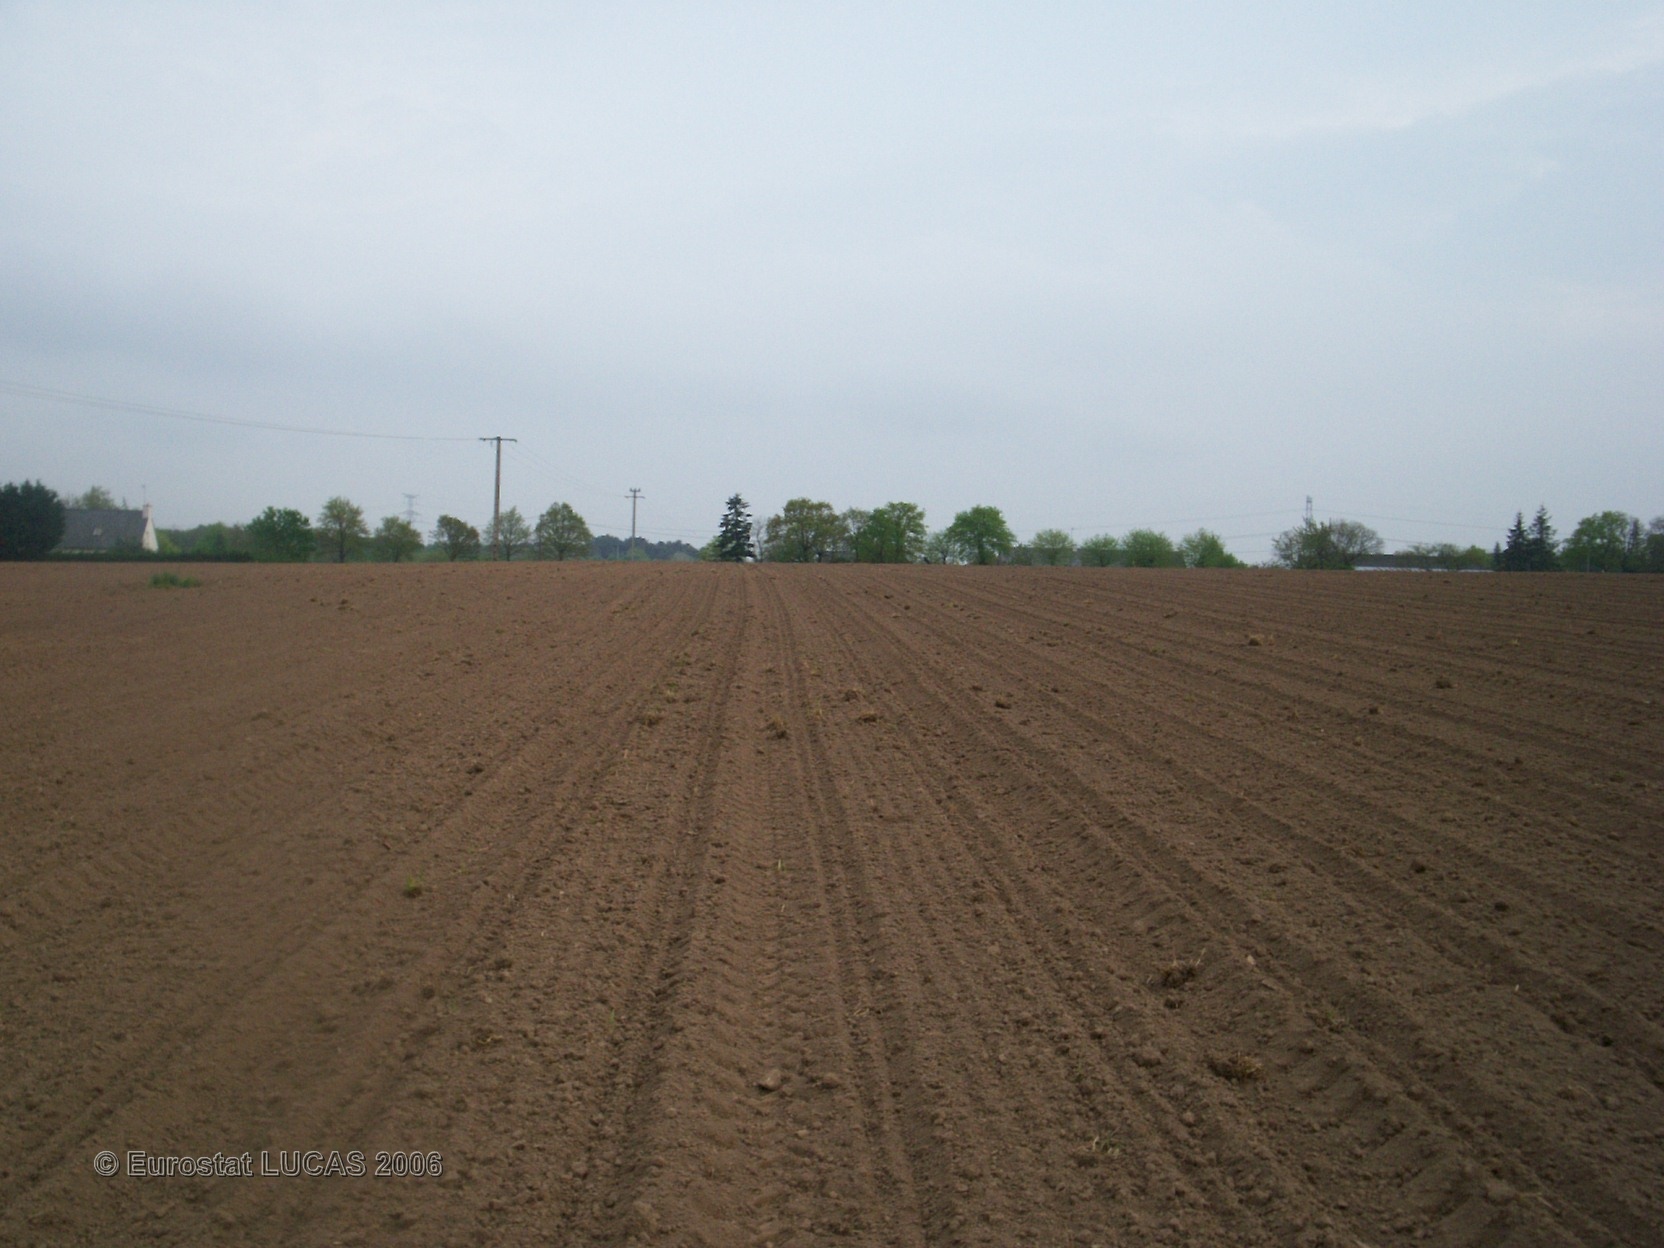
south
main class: Cropland
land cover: Maize
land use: Agriculture (excluding fallow land and kitchen gardens)
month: May
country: FR
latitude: 47.6512
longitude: -2.2085
